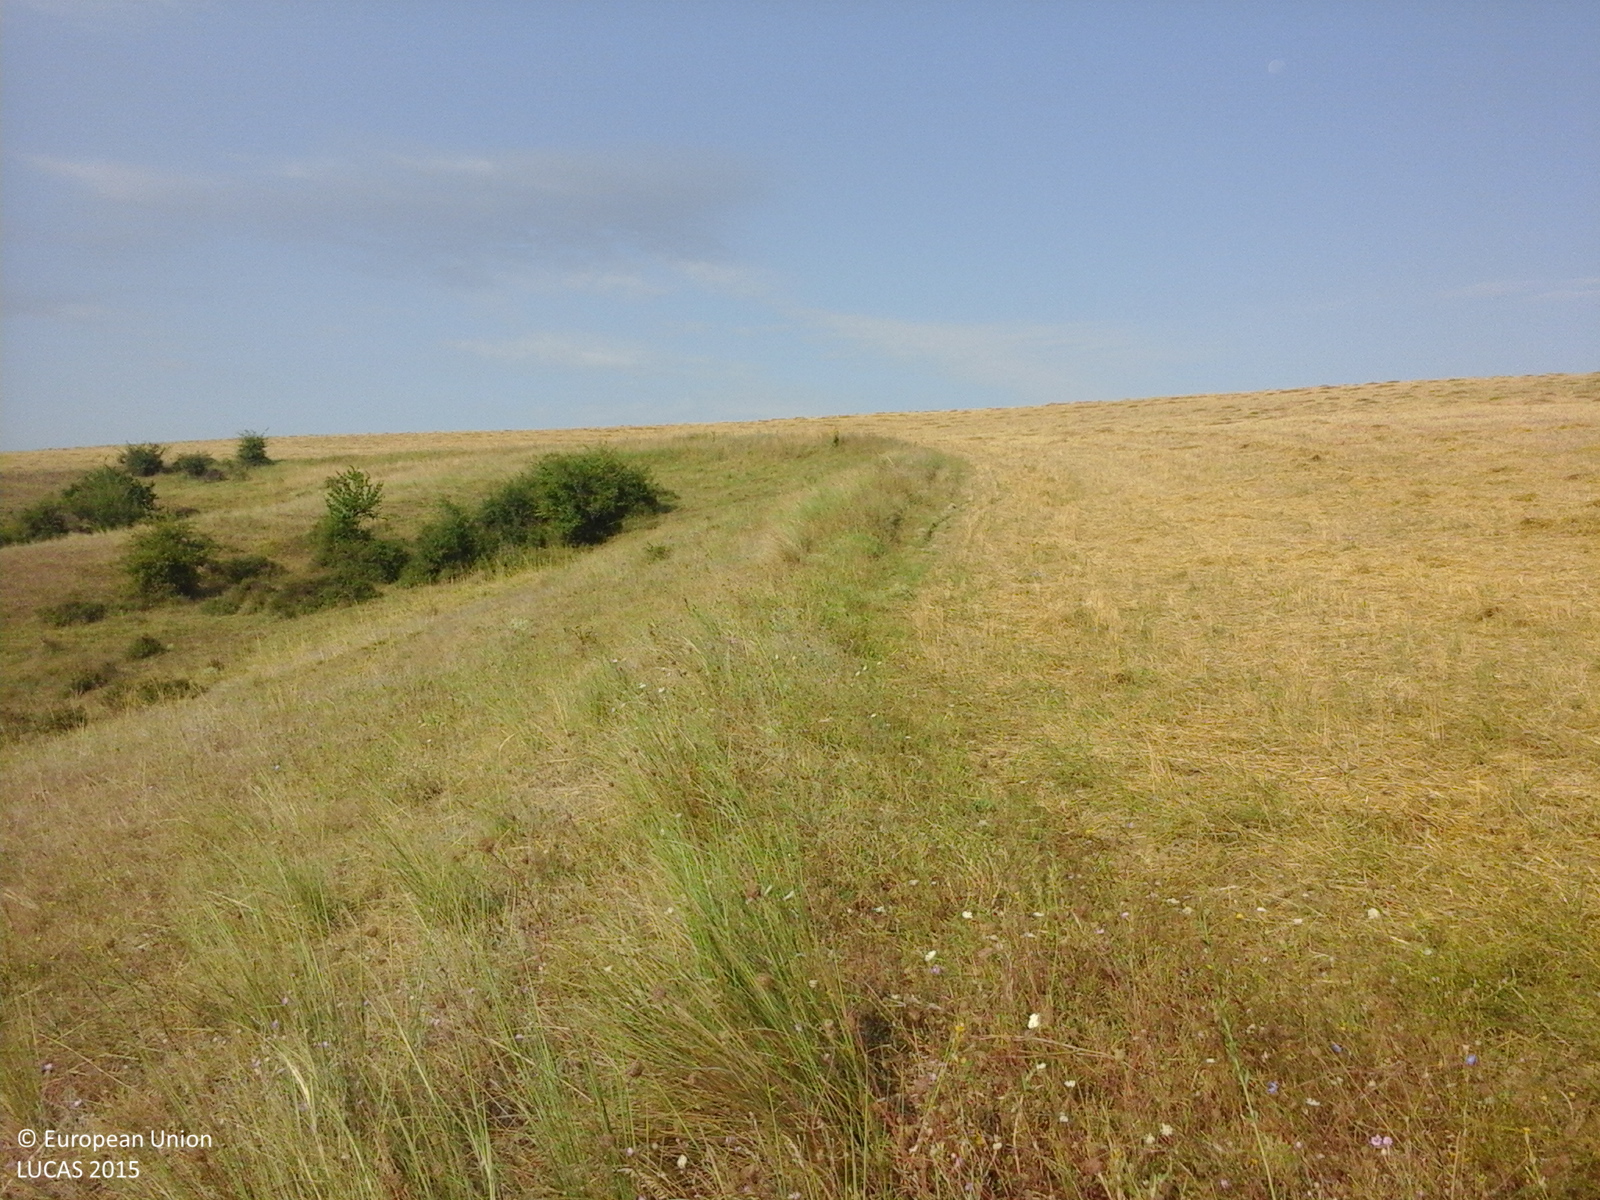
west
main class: Grassland
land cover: Grassland without tree/shrub cover
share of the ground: > 75 %
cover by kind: herbaceous plants 100 %
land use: Agriculture (excluding fallow land and kitchen gardens)
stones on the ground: < 10 %
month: August
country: RO
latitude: 44.0839
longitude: 27.9217
